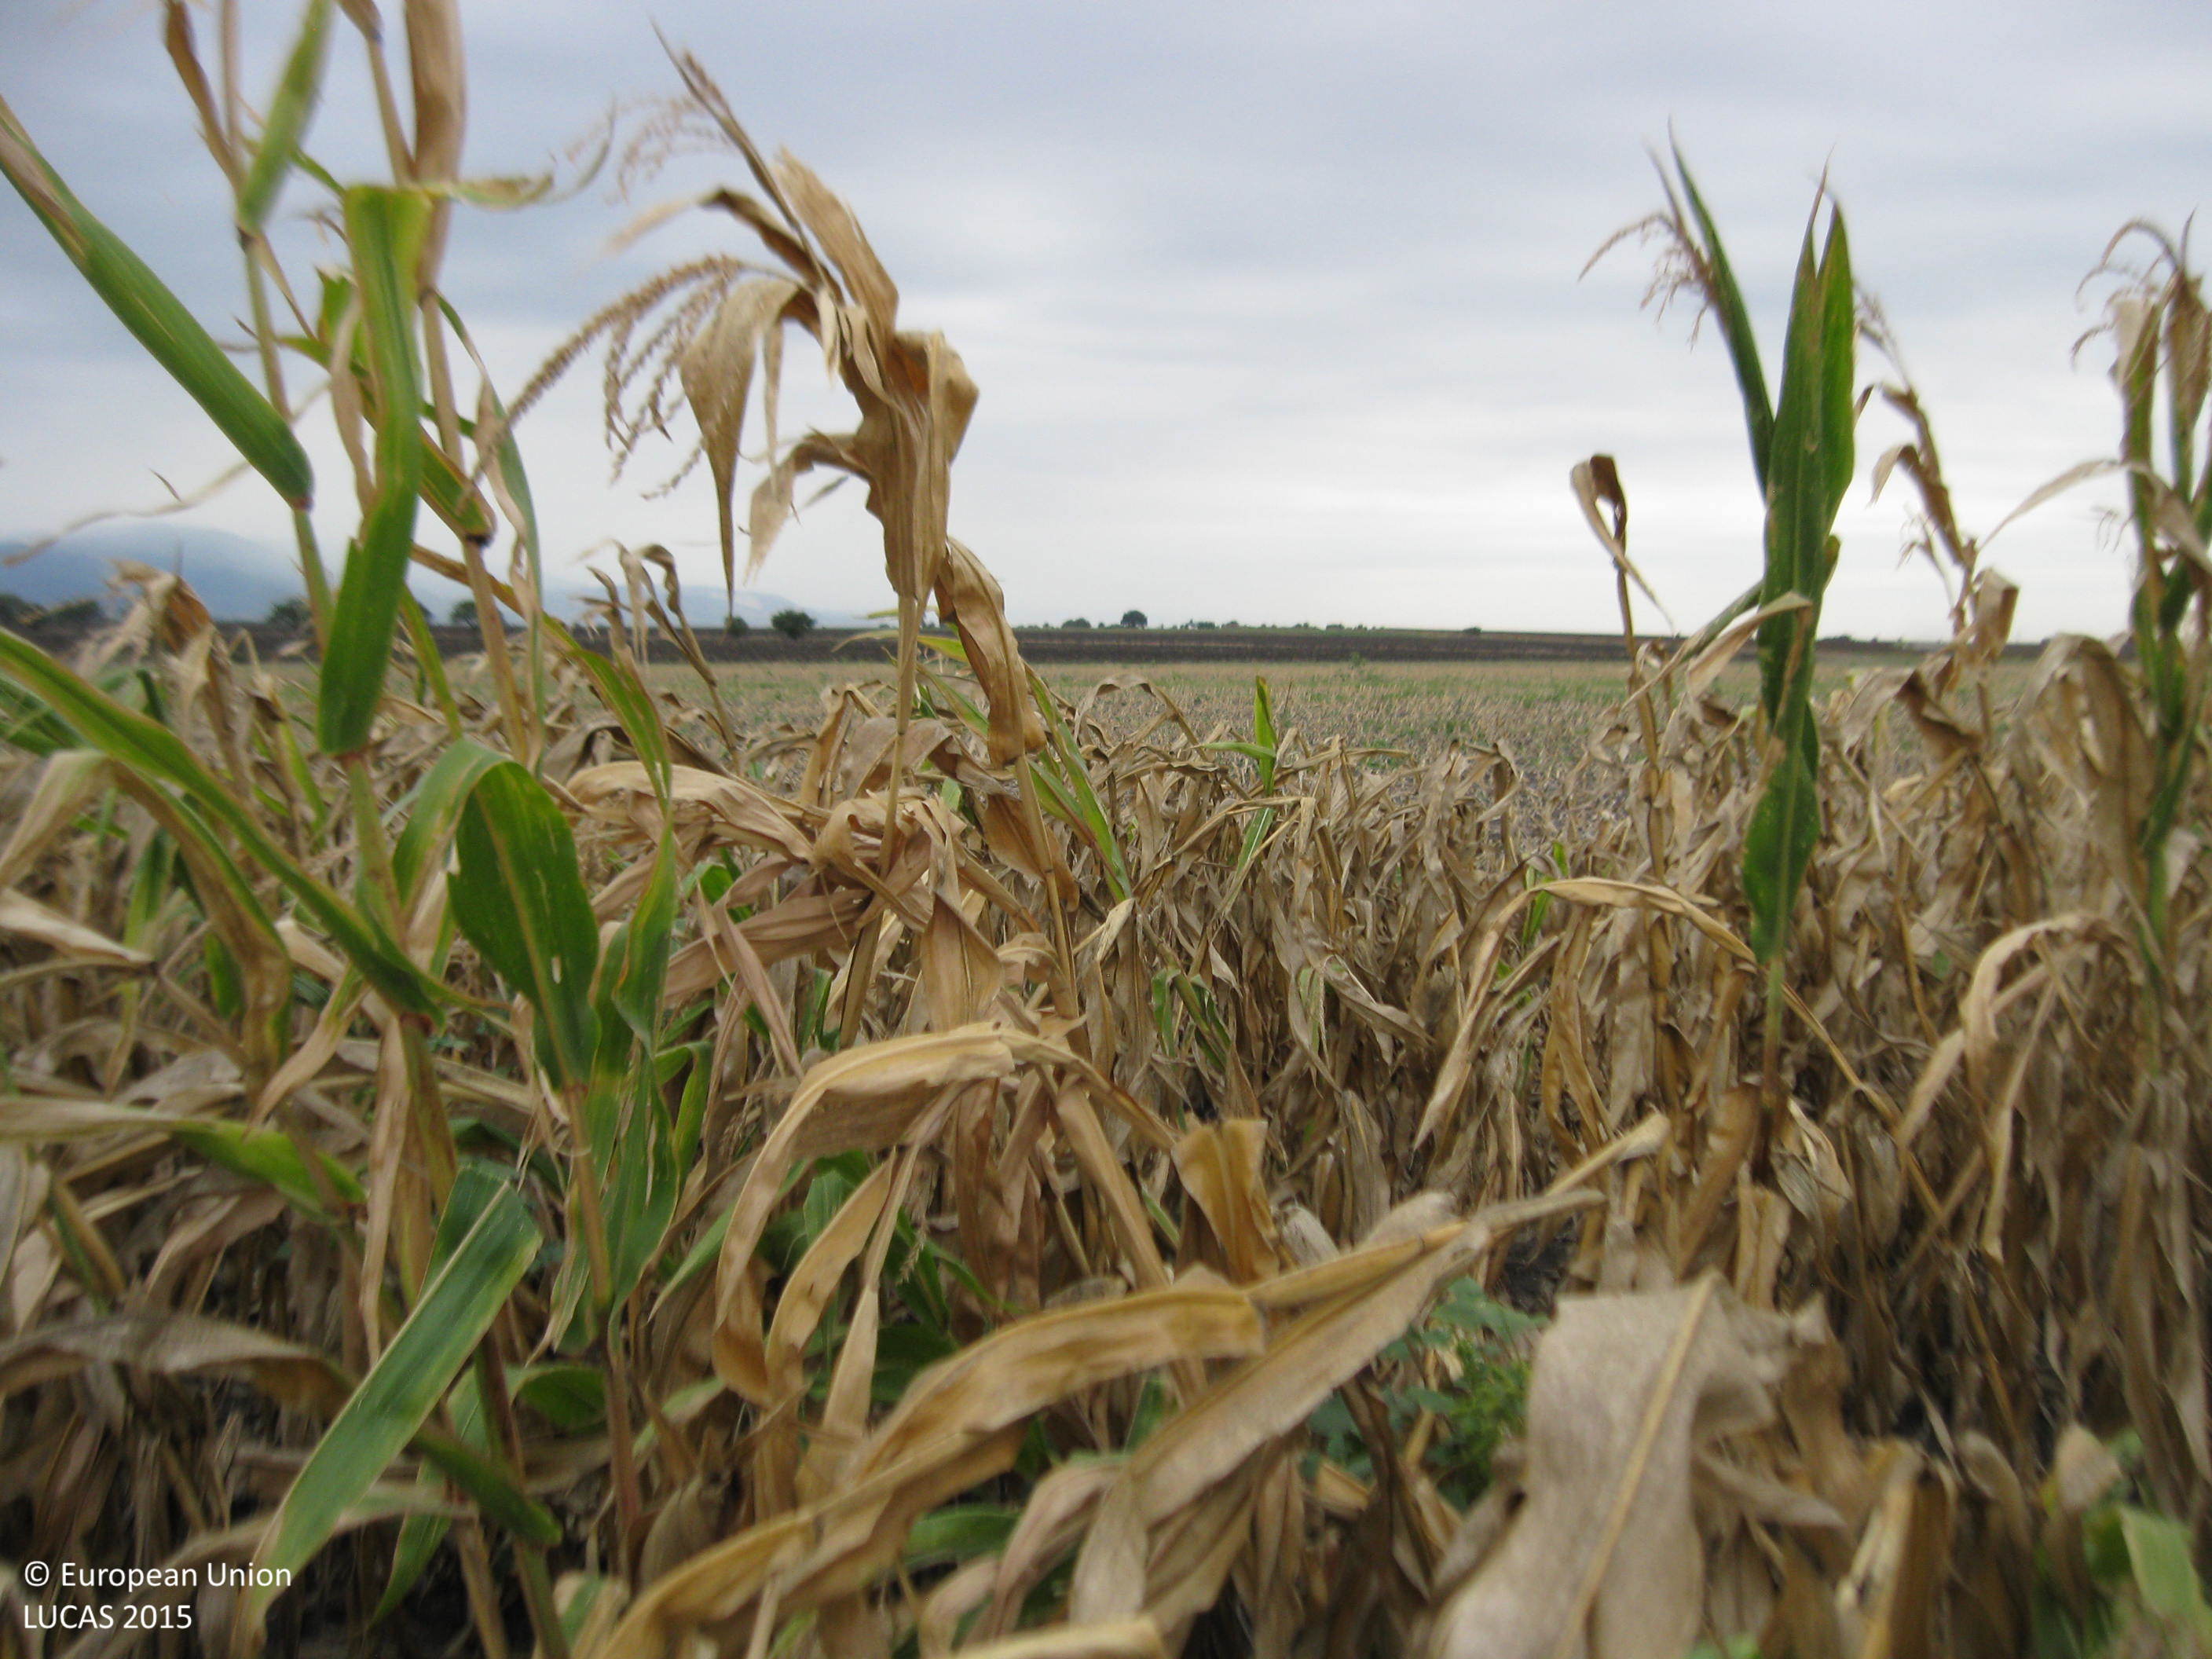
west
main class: Cropland
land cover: Maize
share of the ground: > 75 %
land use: Agriculture (excluding fallow land and kitchen gardens)
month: September
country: BG
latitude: 42.0679
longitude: 25.0791
